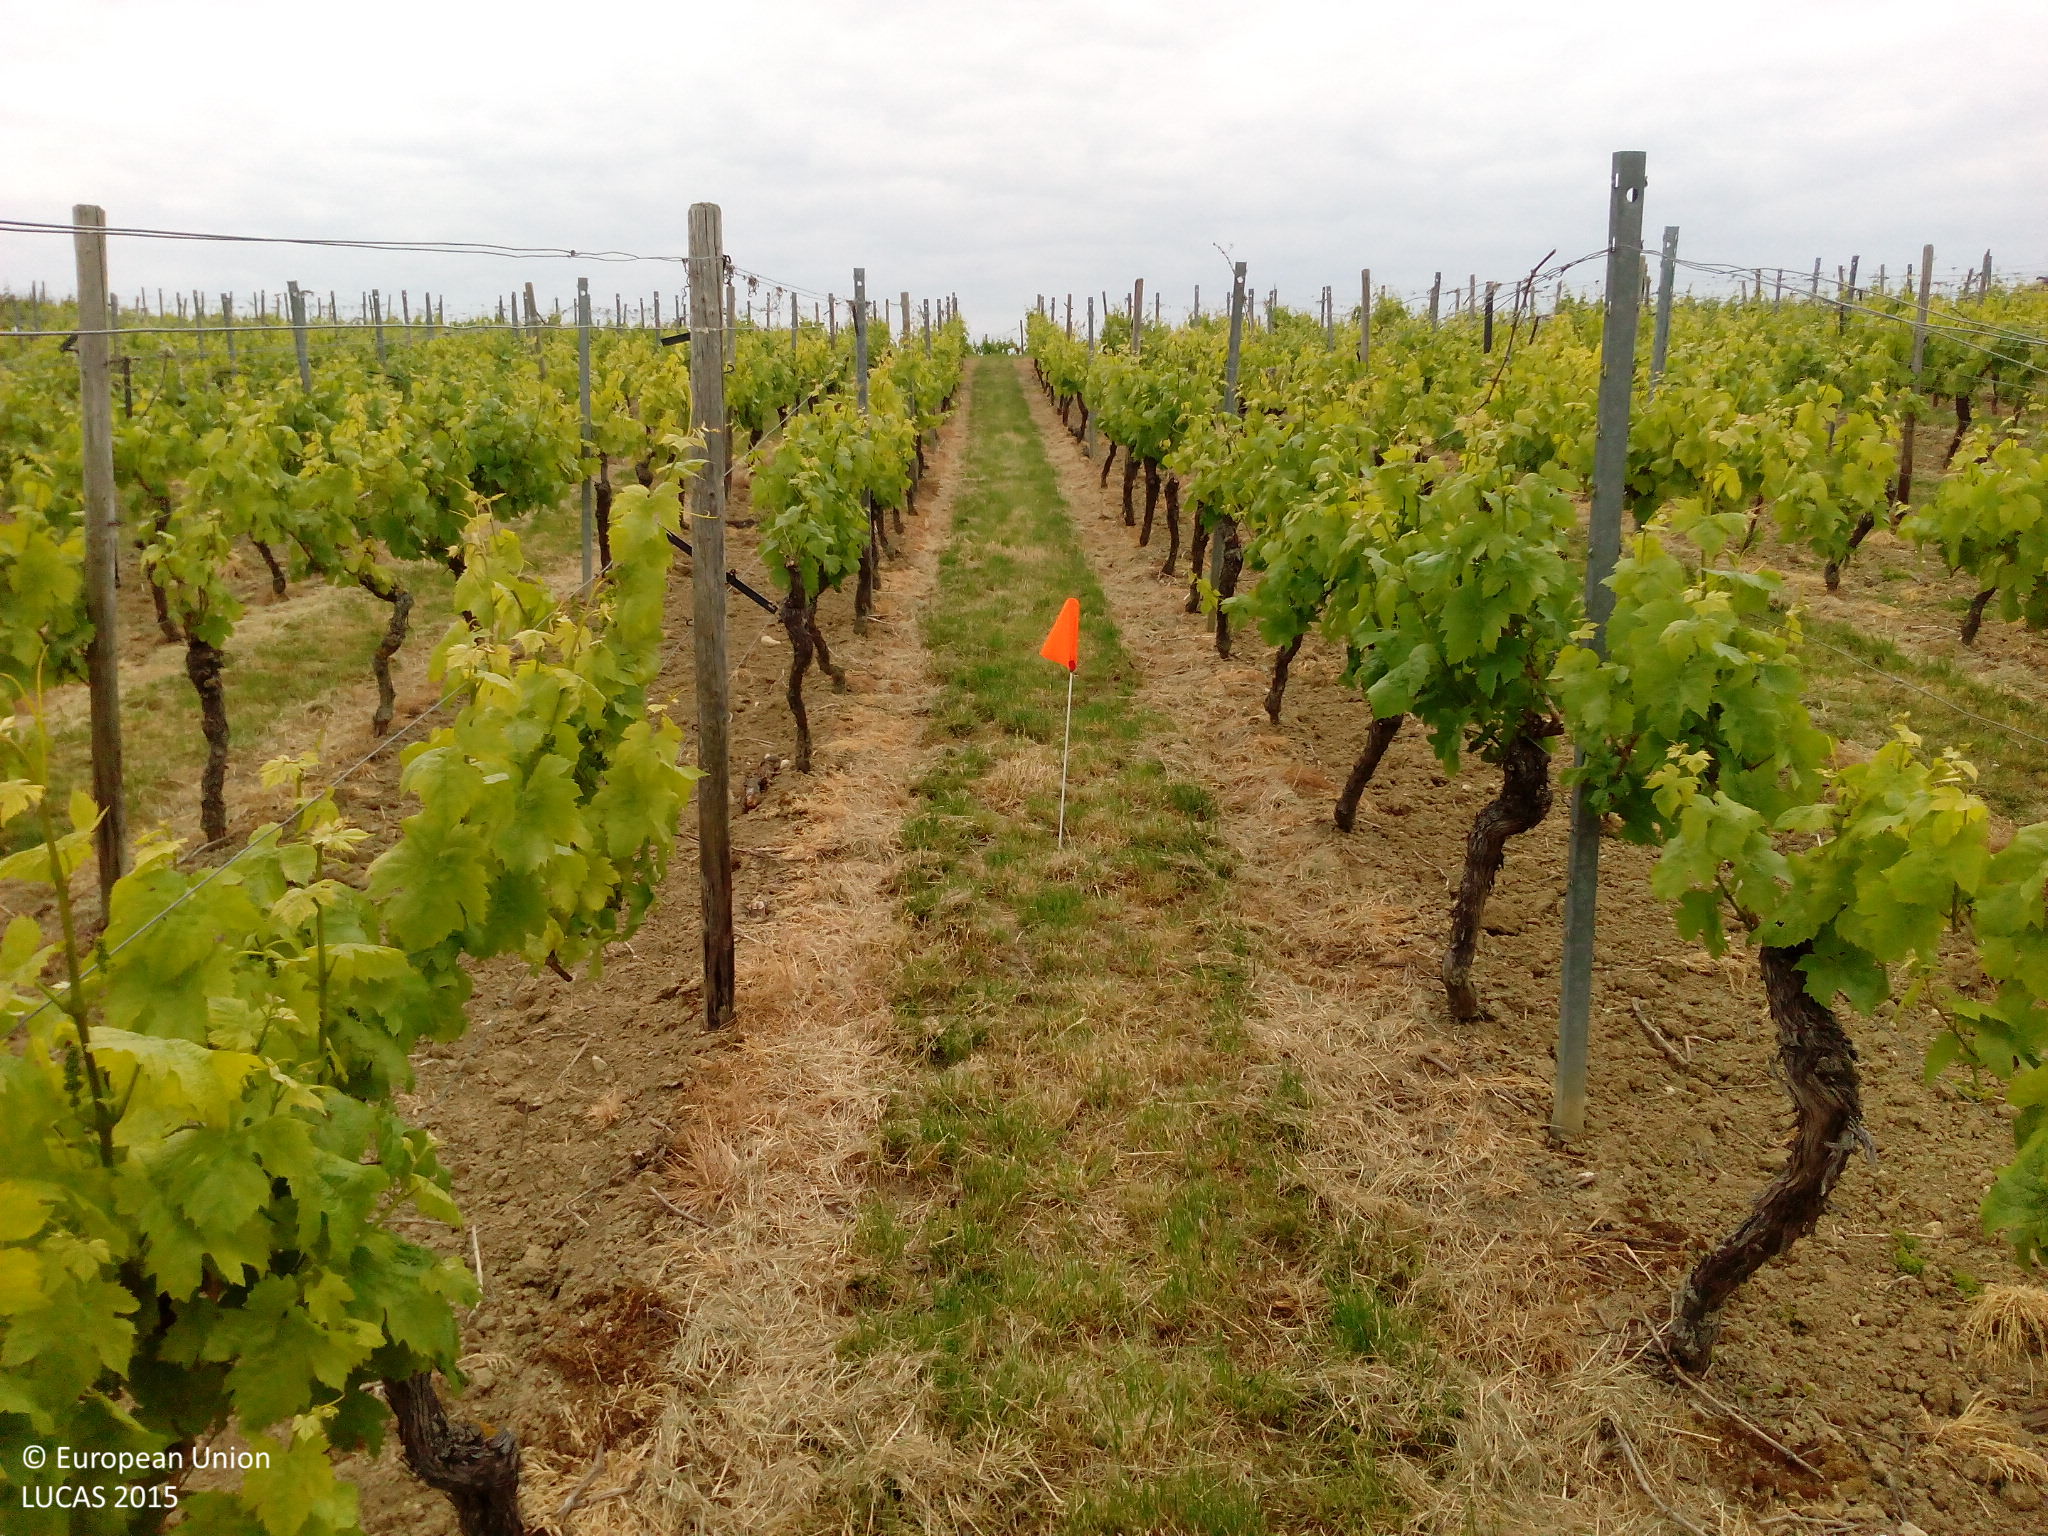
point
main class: Cropland
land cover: Vineyards
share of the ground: 50 - 75 %
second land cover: Grassland without tree/shrub cover
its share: 50 - 75 %
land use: Agriculture (excluding fallow land and kitchen gardens)
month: May
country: DE
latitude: 49.8616
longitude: 8.0390
